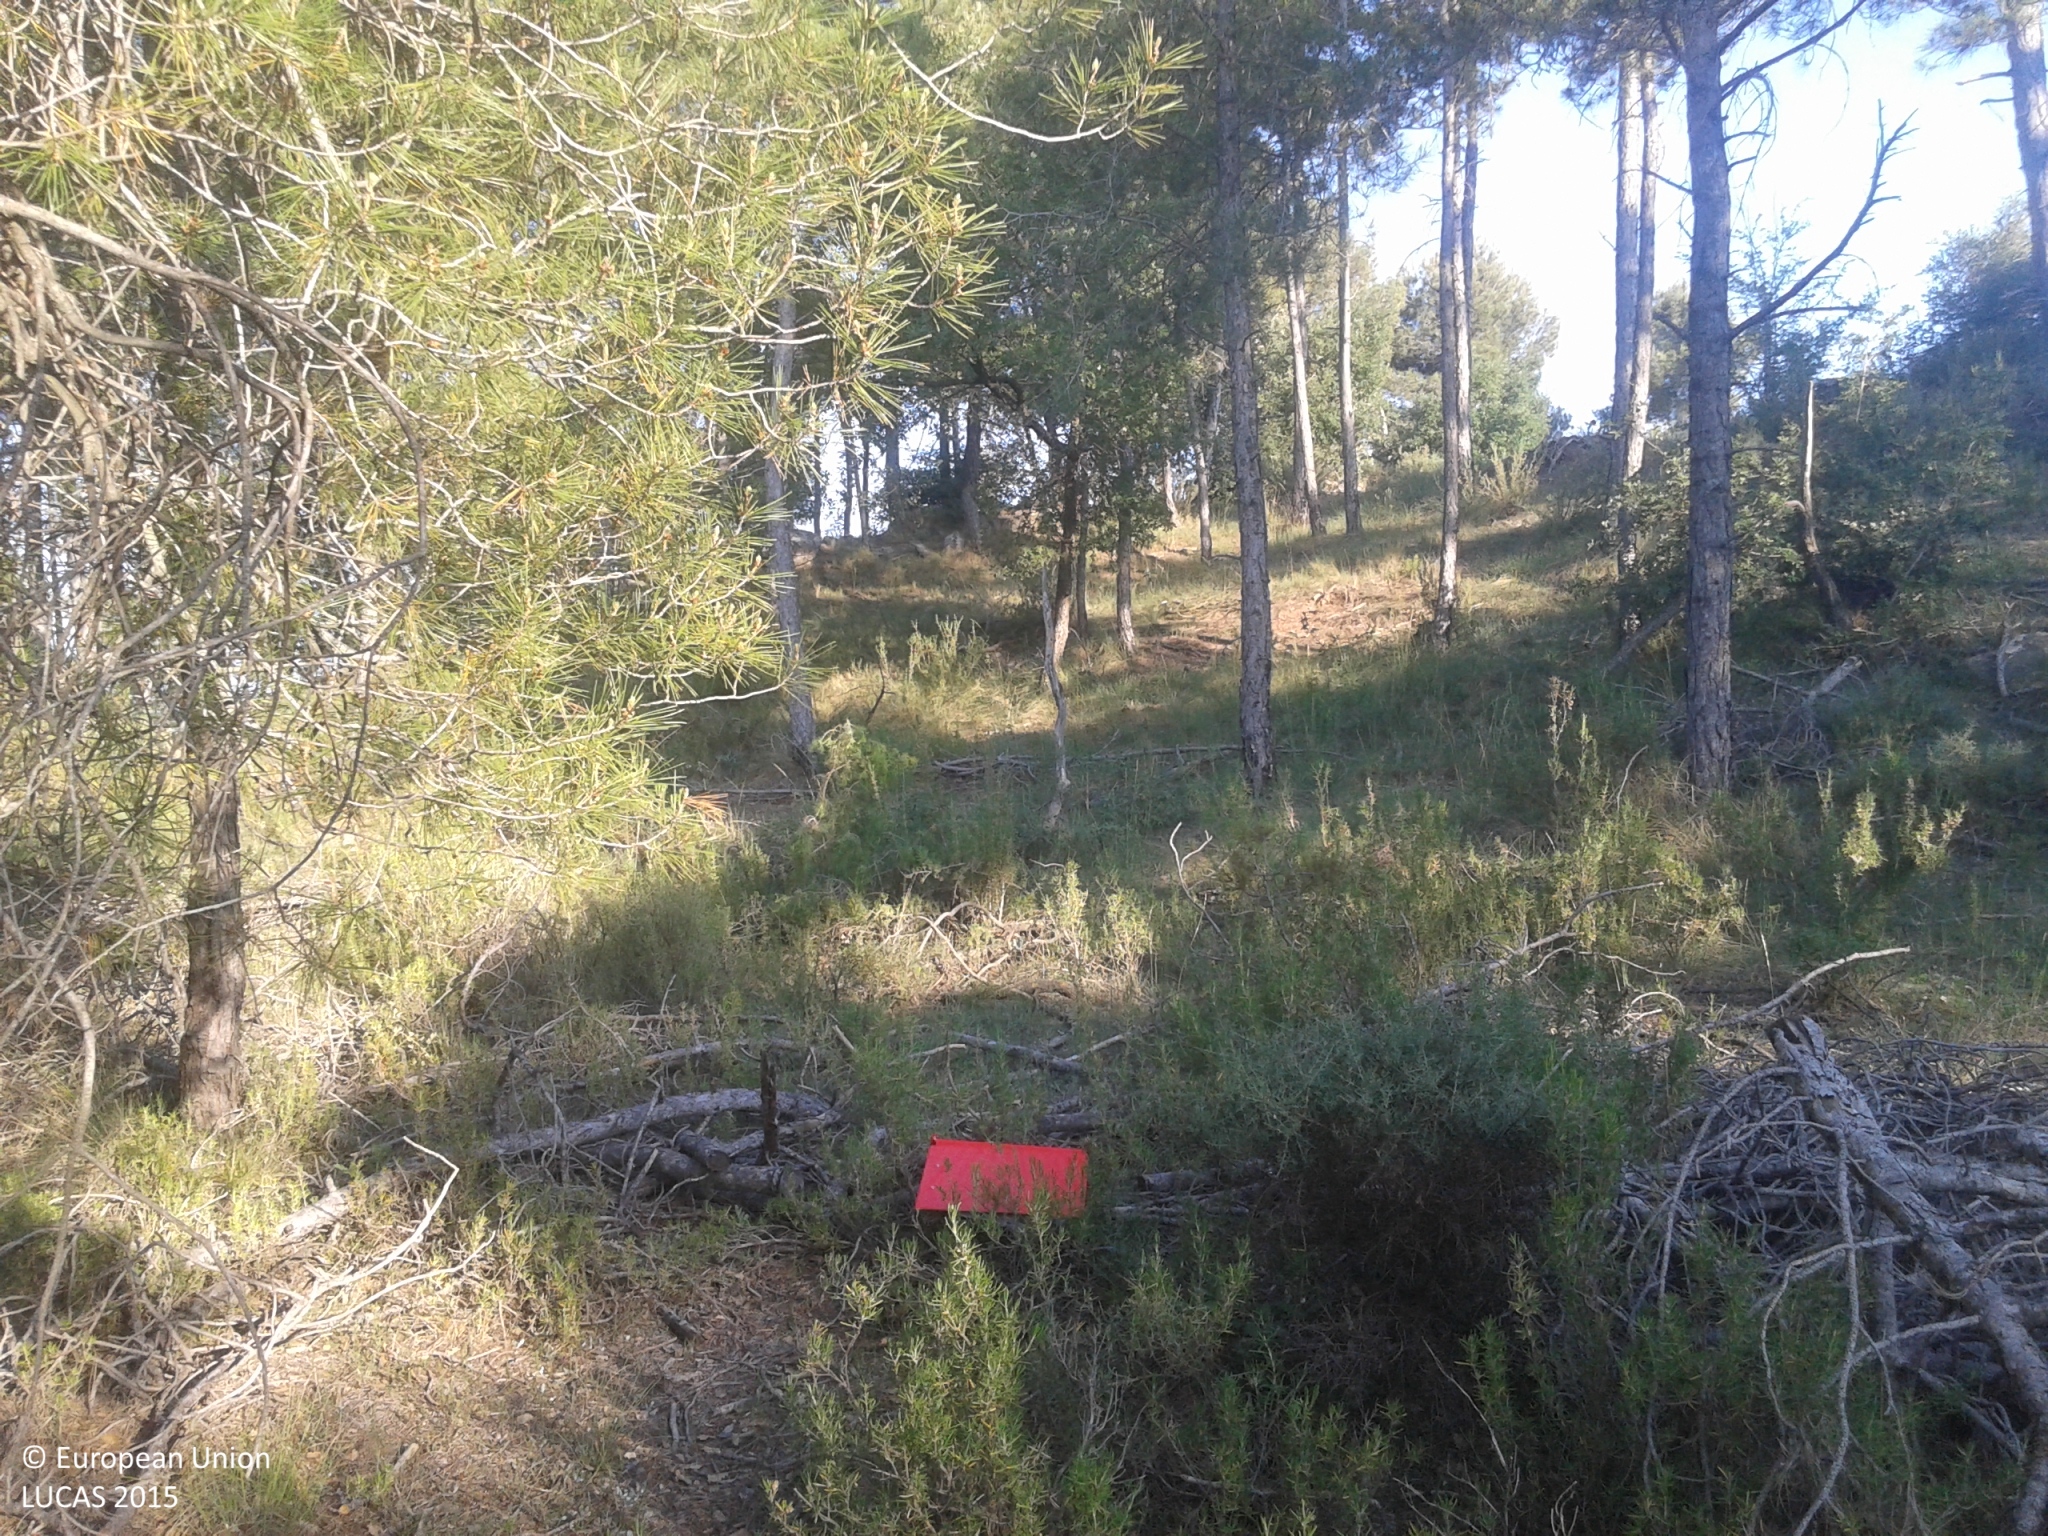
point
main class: Woodland
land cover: Pine dominated mixed woodland
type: coniferous forest of the mediterranean region
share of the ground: > 75 %
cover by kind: coniferous forest trees 60 %, broadleaved forest trees 20 %, shrubs 10 %, herbaceous plants 10 %
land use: Forestry
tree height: > 5 m
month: June
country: ES
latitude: 41.9620
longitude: 1.6275
